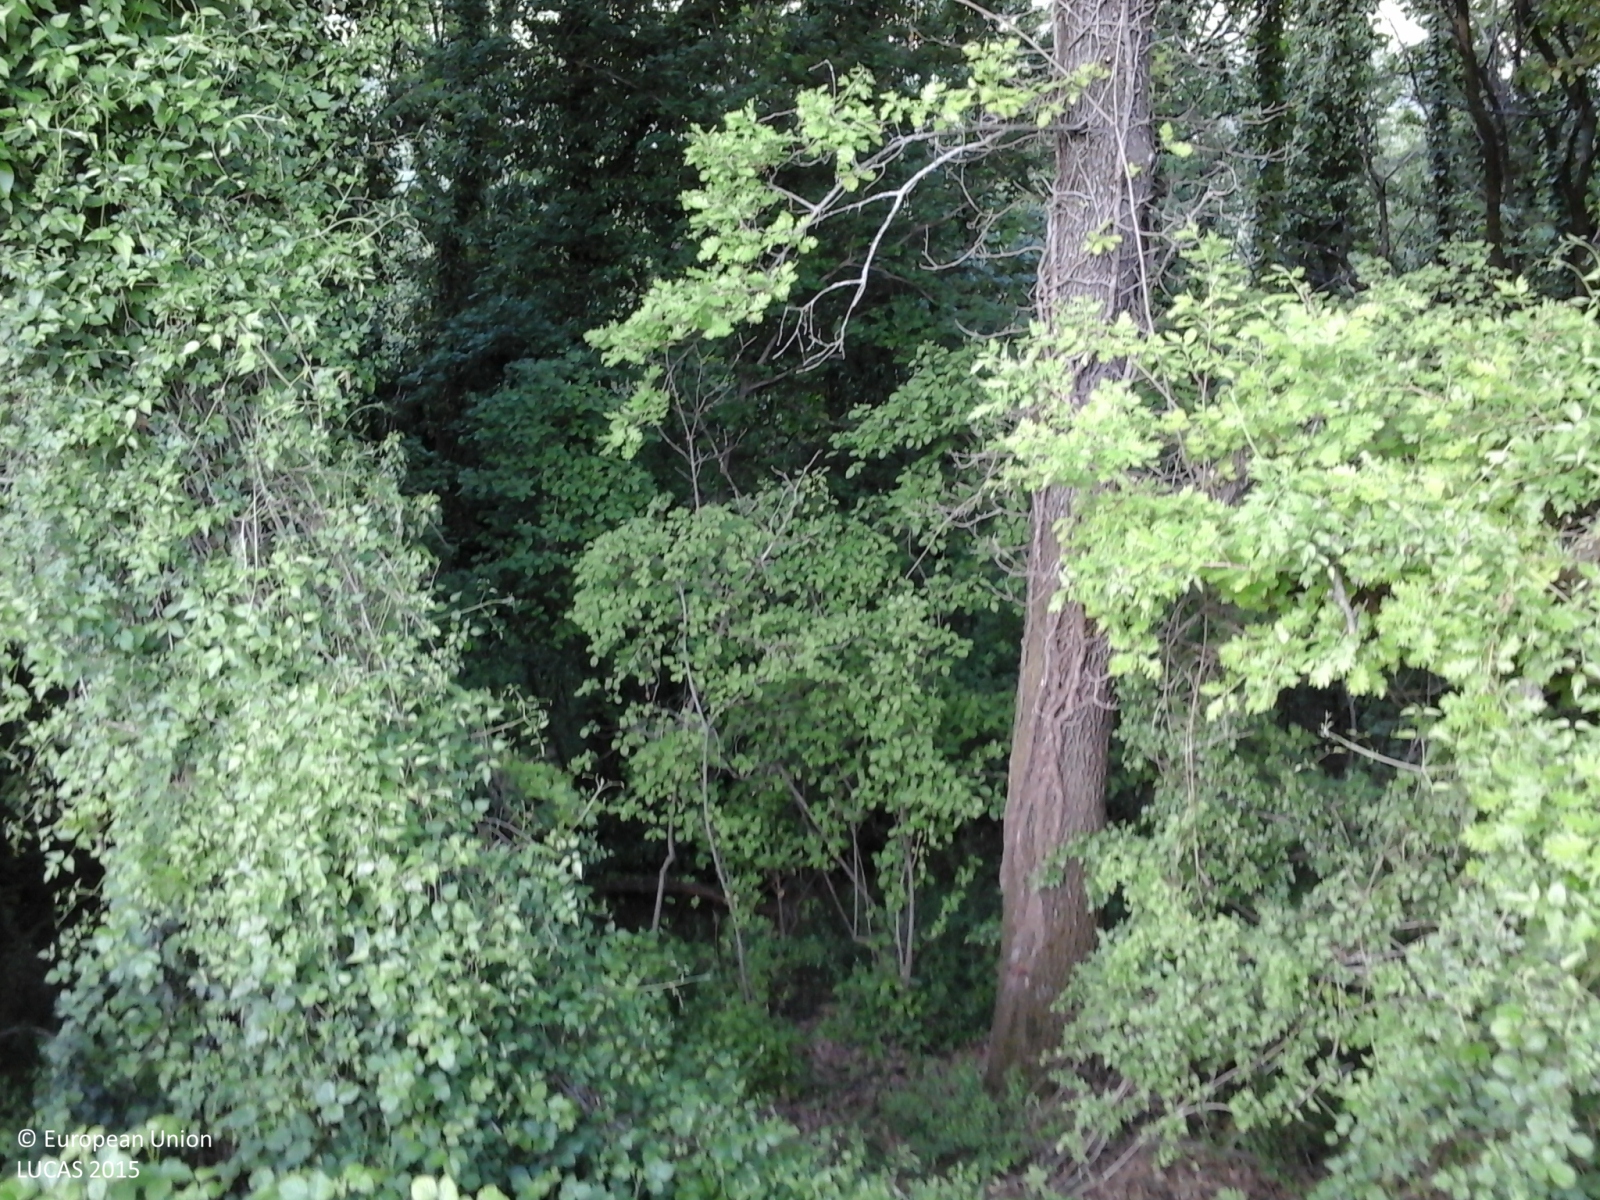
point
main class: Woodland
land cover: Broadleaved woodland
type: mesophytic deciduous forest
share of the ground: > 75 %
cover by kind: broadleaved forest trees 80 %, shrubs 20 %
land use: Forestry
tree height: > 5 m
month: April
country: IT
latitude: 44.9081
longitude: 9.4565
